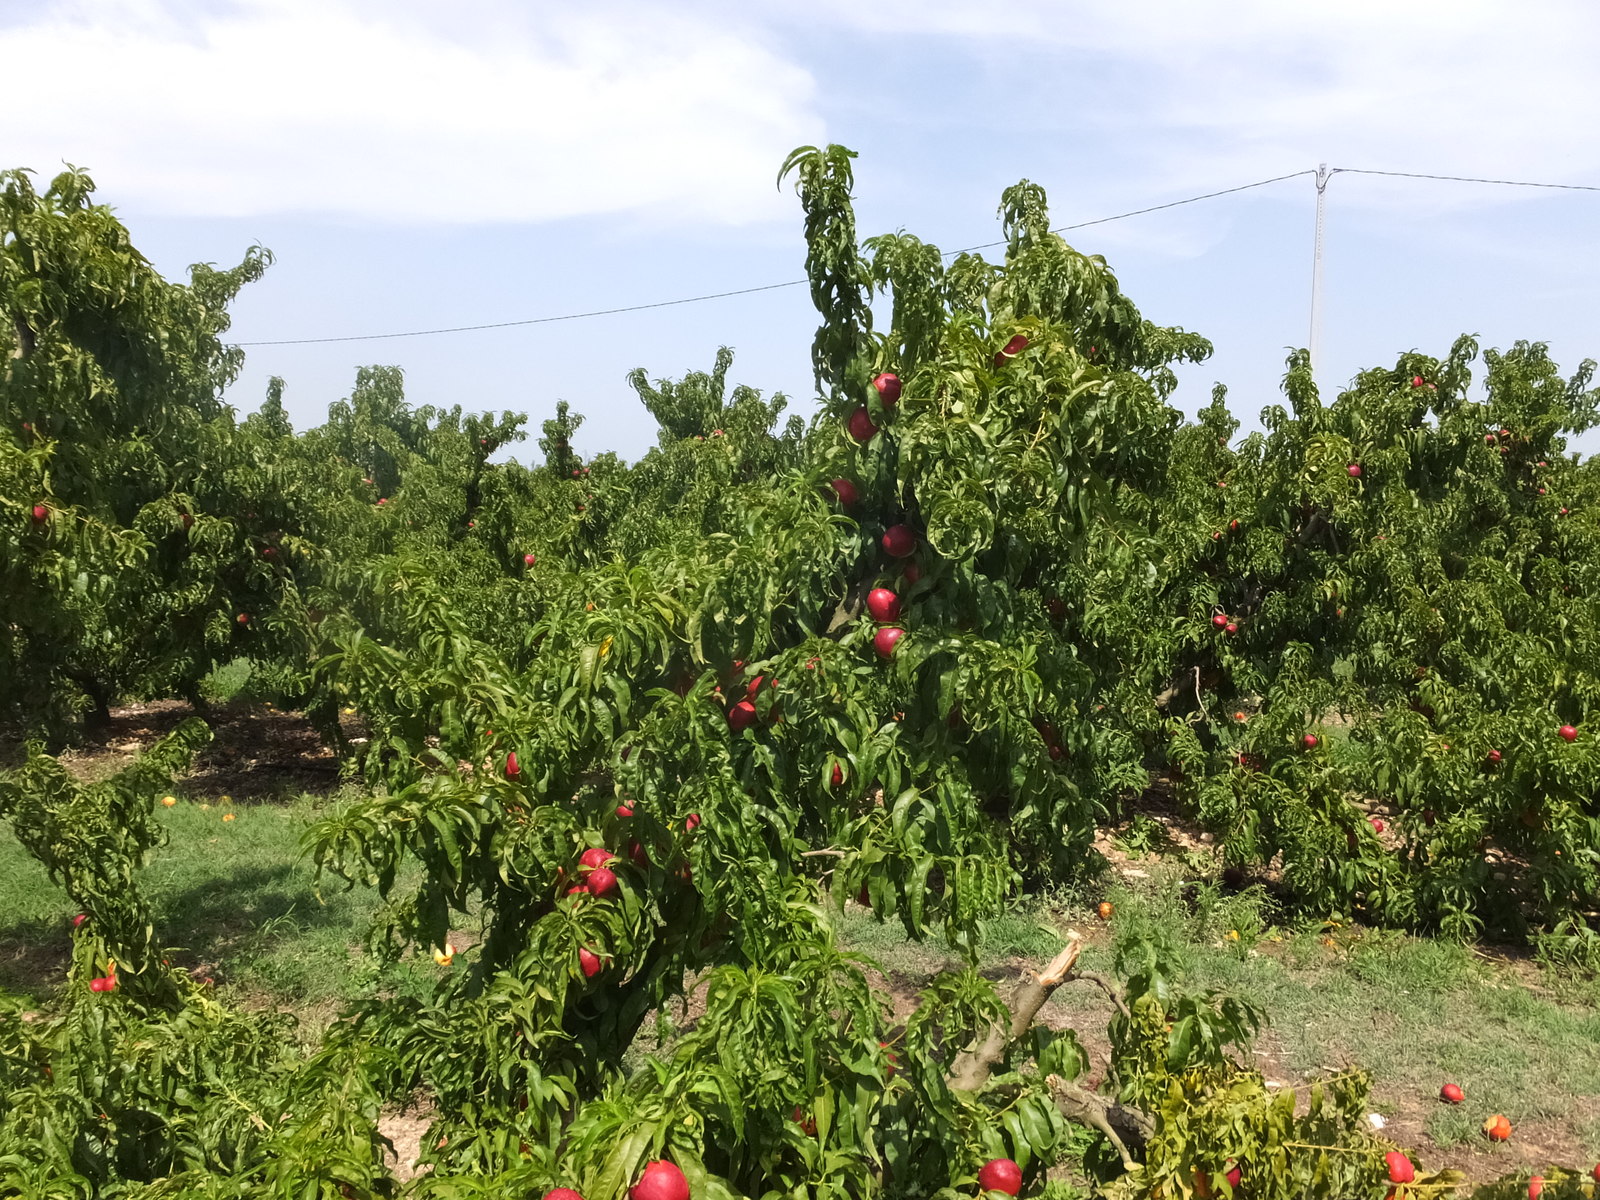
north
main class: Cropland
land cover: Other fruit trees and berries
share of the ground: > 75 %
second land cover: Spontaneously vegetated surfaces
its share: < 10 %
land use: Agriculture (excluding fallow land and kitchen gardens)
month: August
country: ES
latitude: 41.5949
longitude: 0.3771
